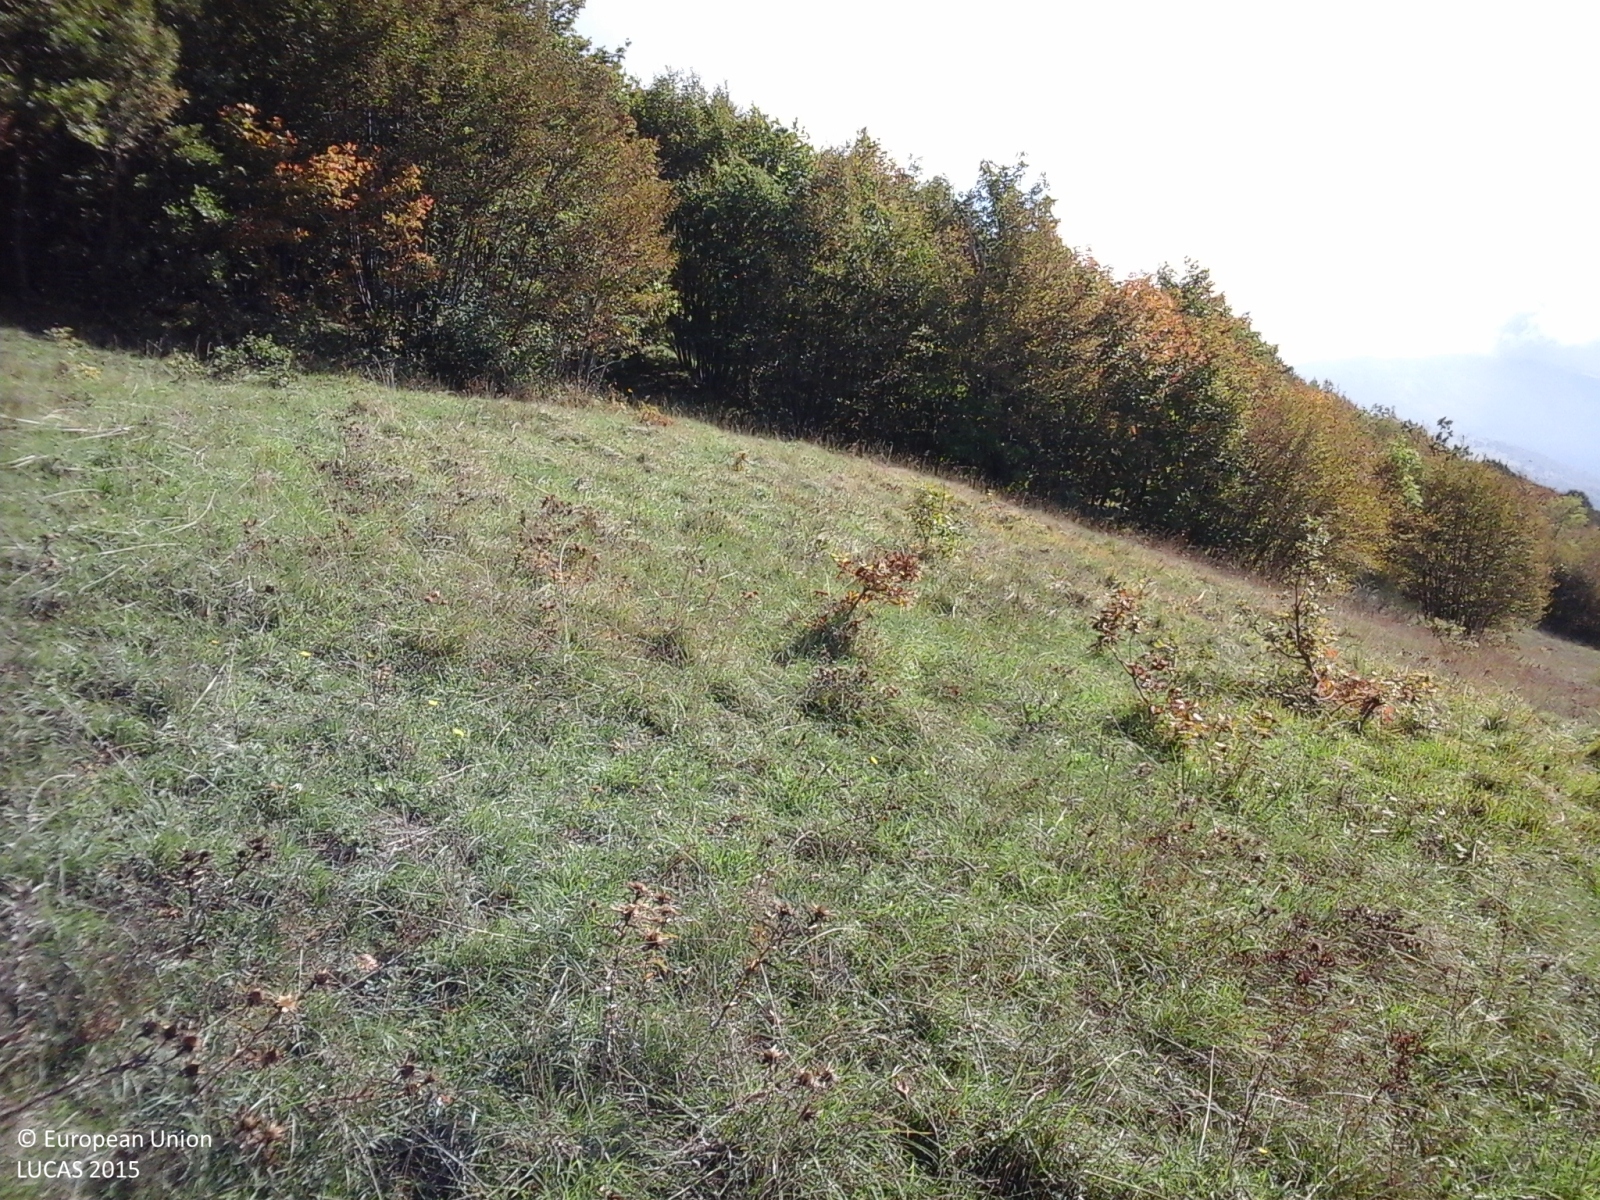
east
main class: Grassland
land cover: Grassland without tree/shrub cover
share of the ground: > 75 %
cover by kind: herbaceous plants 100 %
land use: Agriculture (excluding fallow land and kitchen gardens)
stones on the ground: < 10 %
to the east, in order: Grassland without tree/shrub cover; Broadleaved woodland
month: October
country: IT
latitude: 43.5057
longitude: 12.6030
